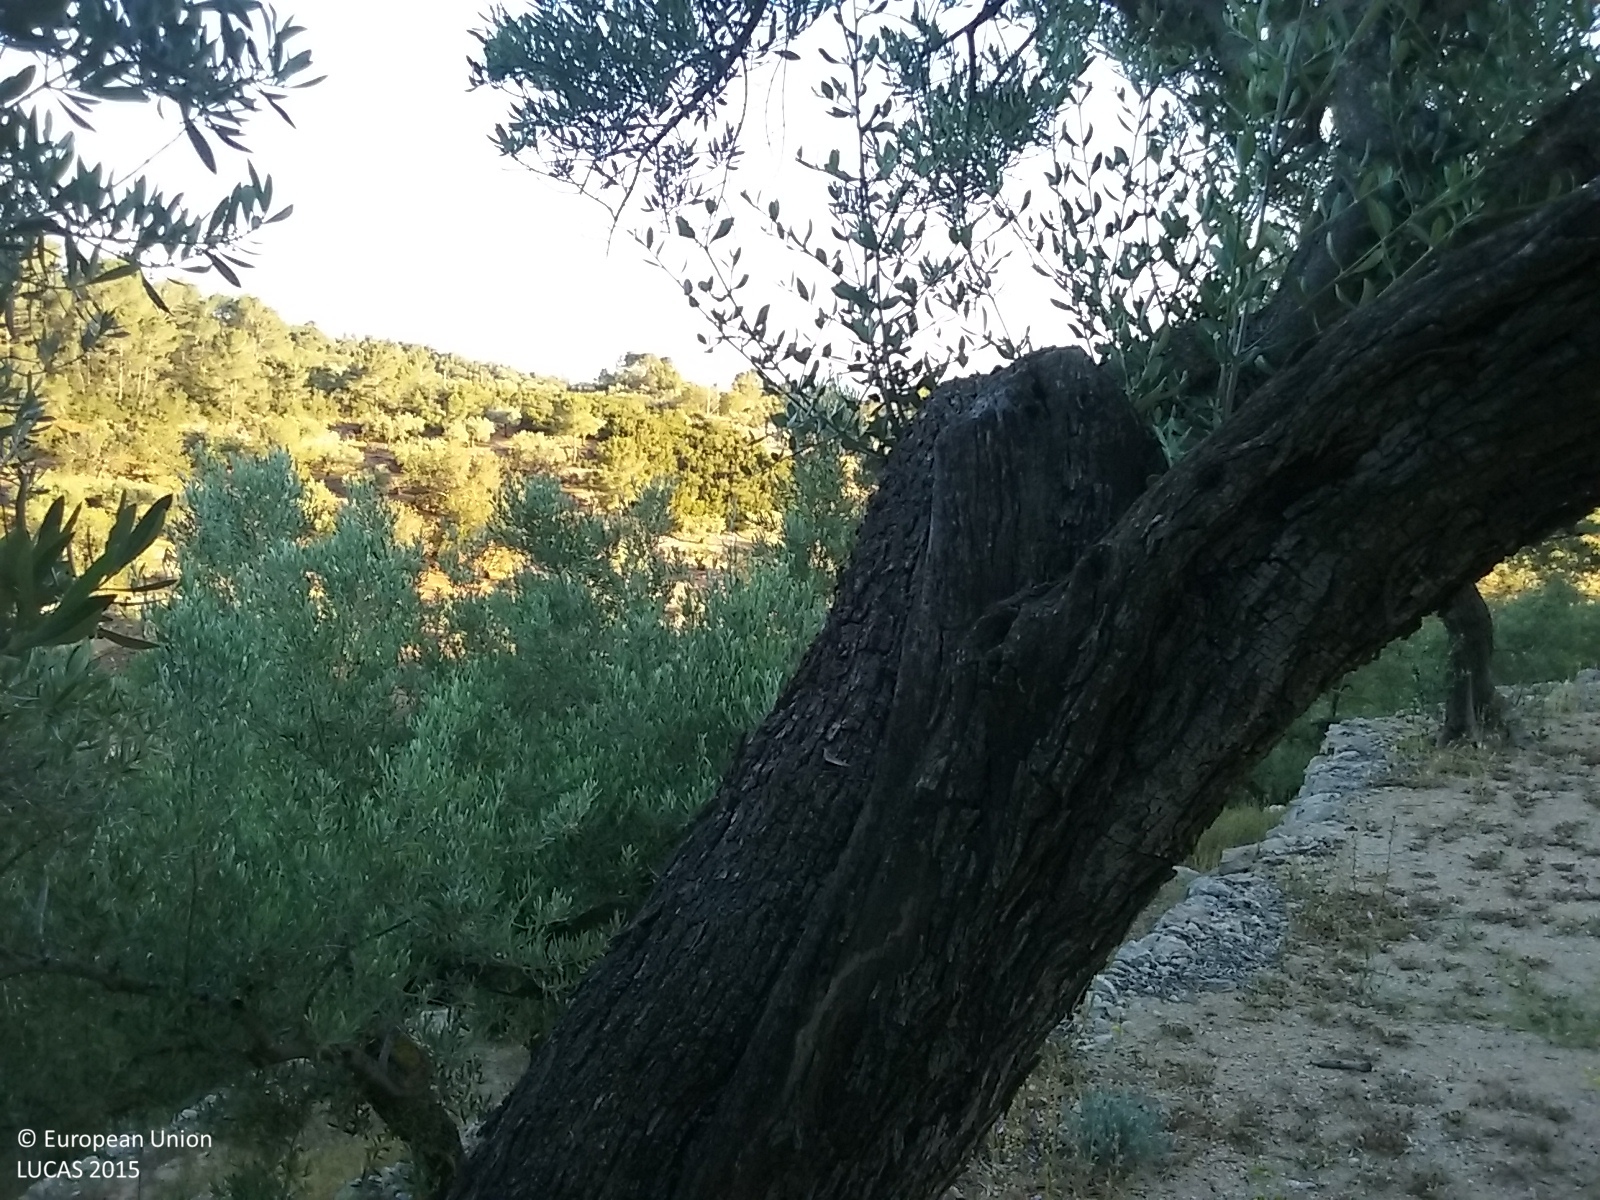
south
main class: Cropland
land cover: Olive groves
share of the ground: 25 - 50 %
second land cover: Spontaneously vegetated surfaces
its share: 10 - 25 %
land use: Agriculture (excluding fallow land and kitchen gardens)
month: May
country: ES
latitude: 40.7929
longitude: 0.5485
